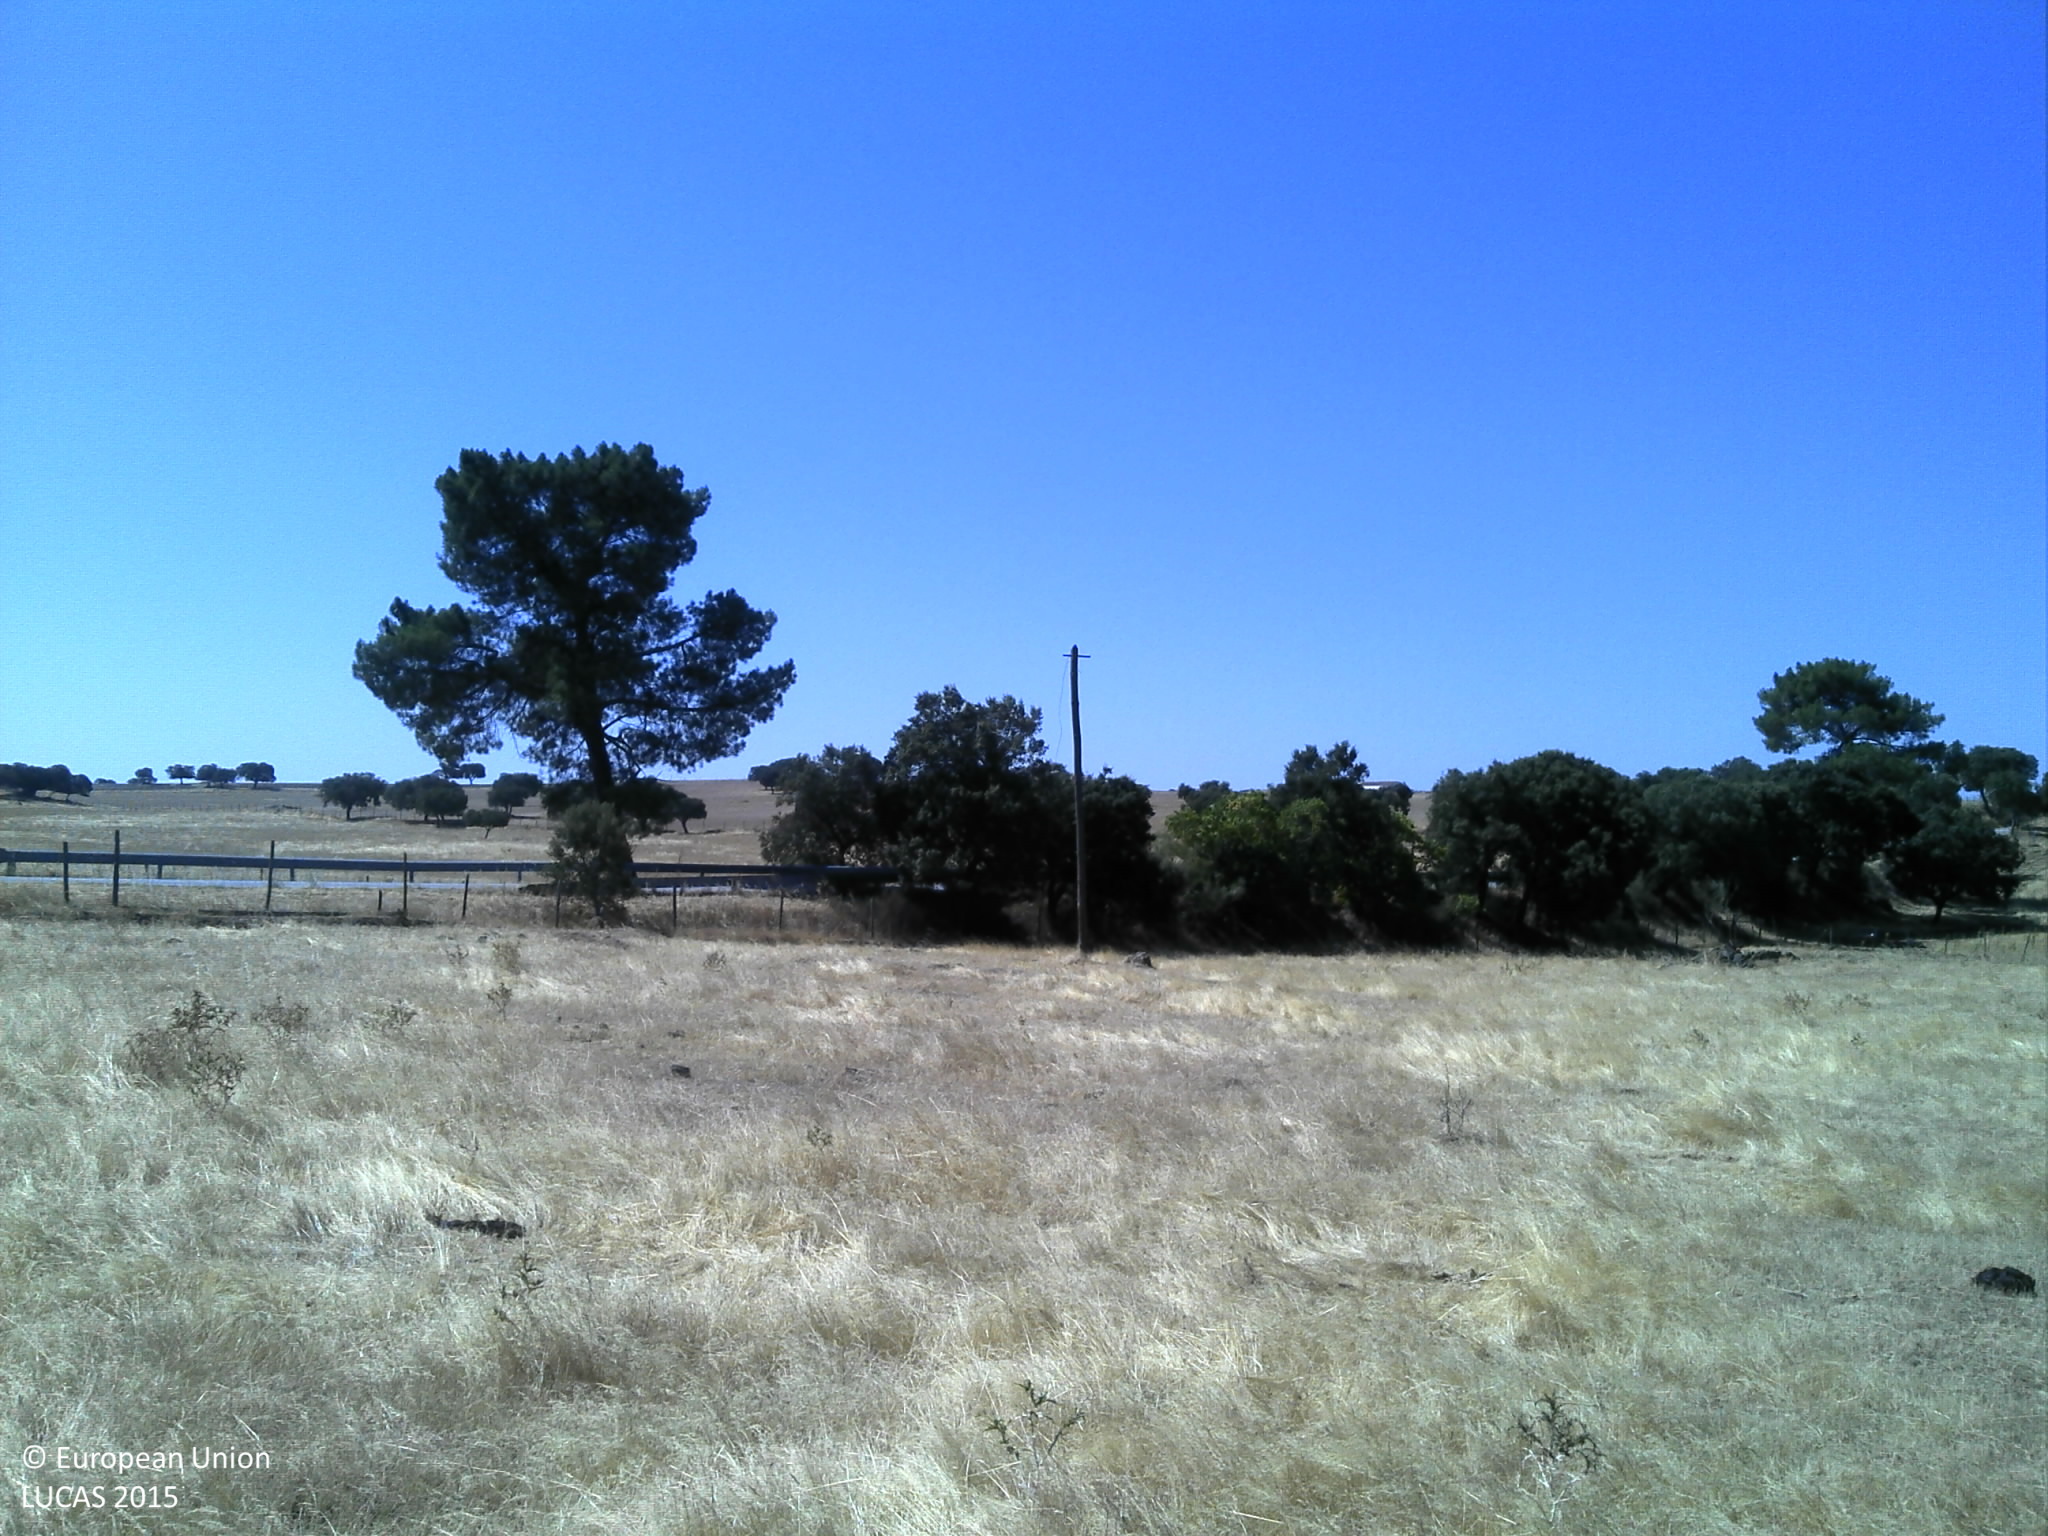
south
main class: Grassland
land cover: Grassland without tree/shrub cover
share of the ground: 50 - 75 %
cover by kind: herbaceous plants 60 %, unconsolidated bare surface 40 %
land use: Agriculture (excluding fallow land and kitchen gardens)
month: July
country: PT
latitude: 39.1195
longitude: -7.4221
